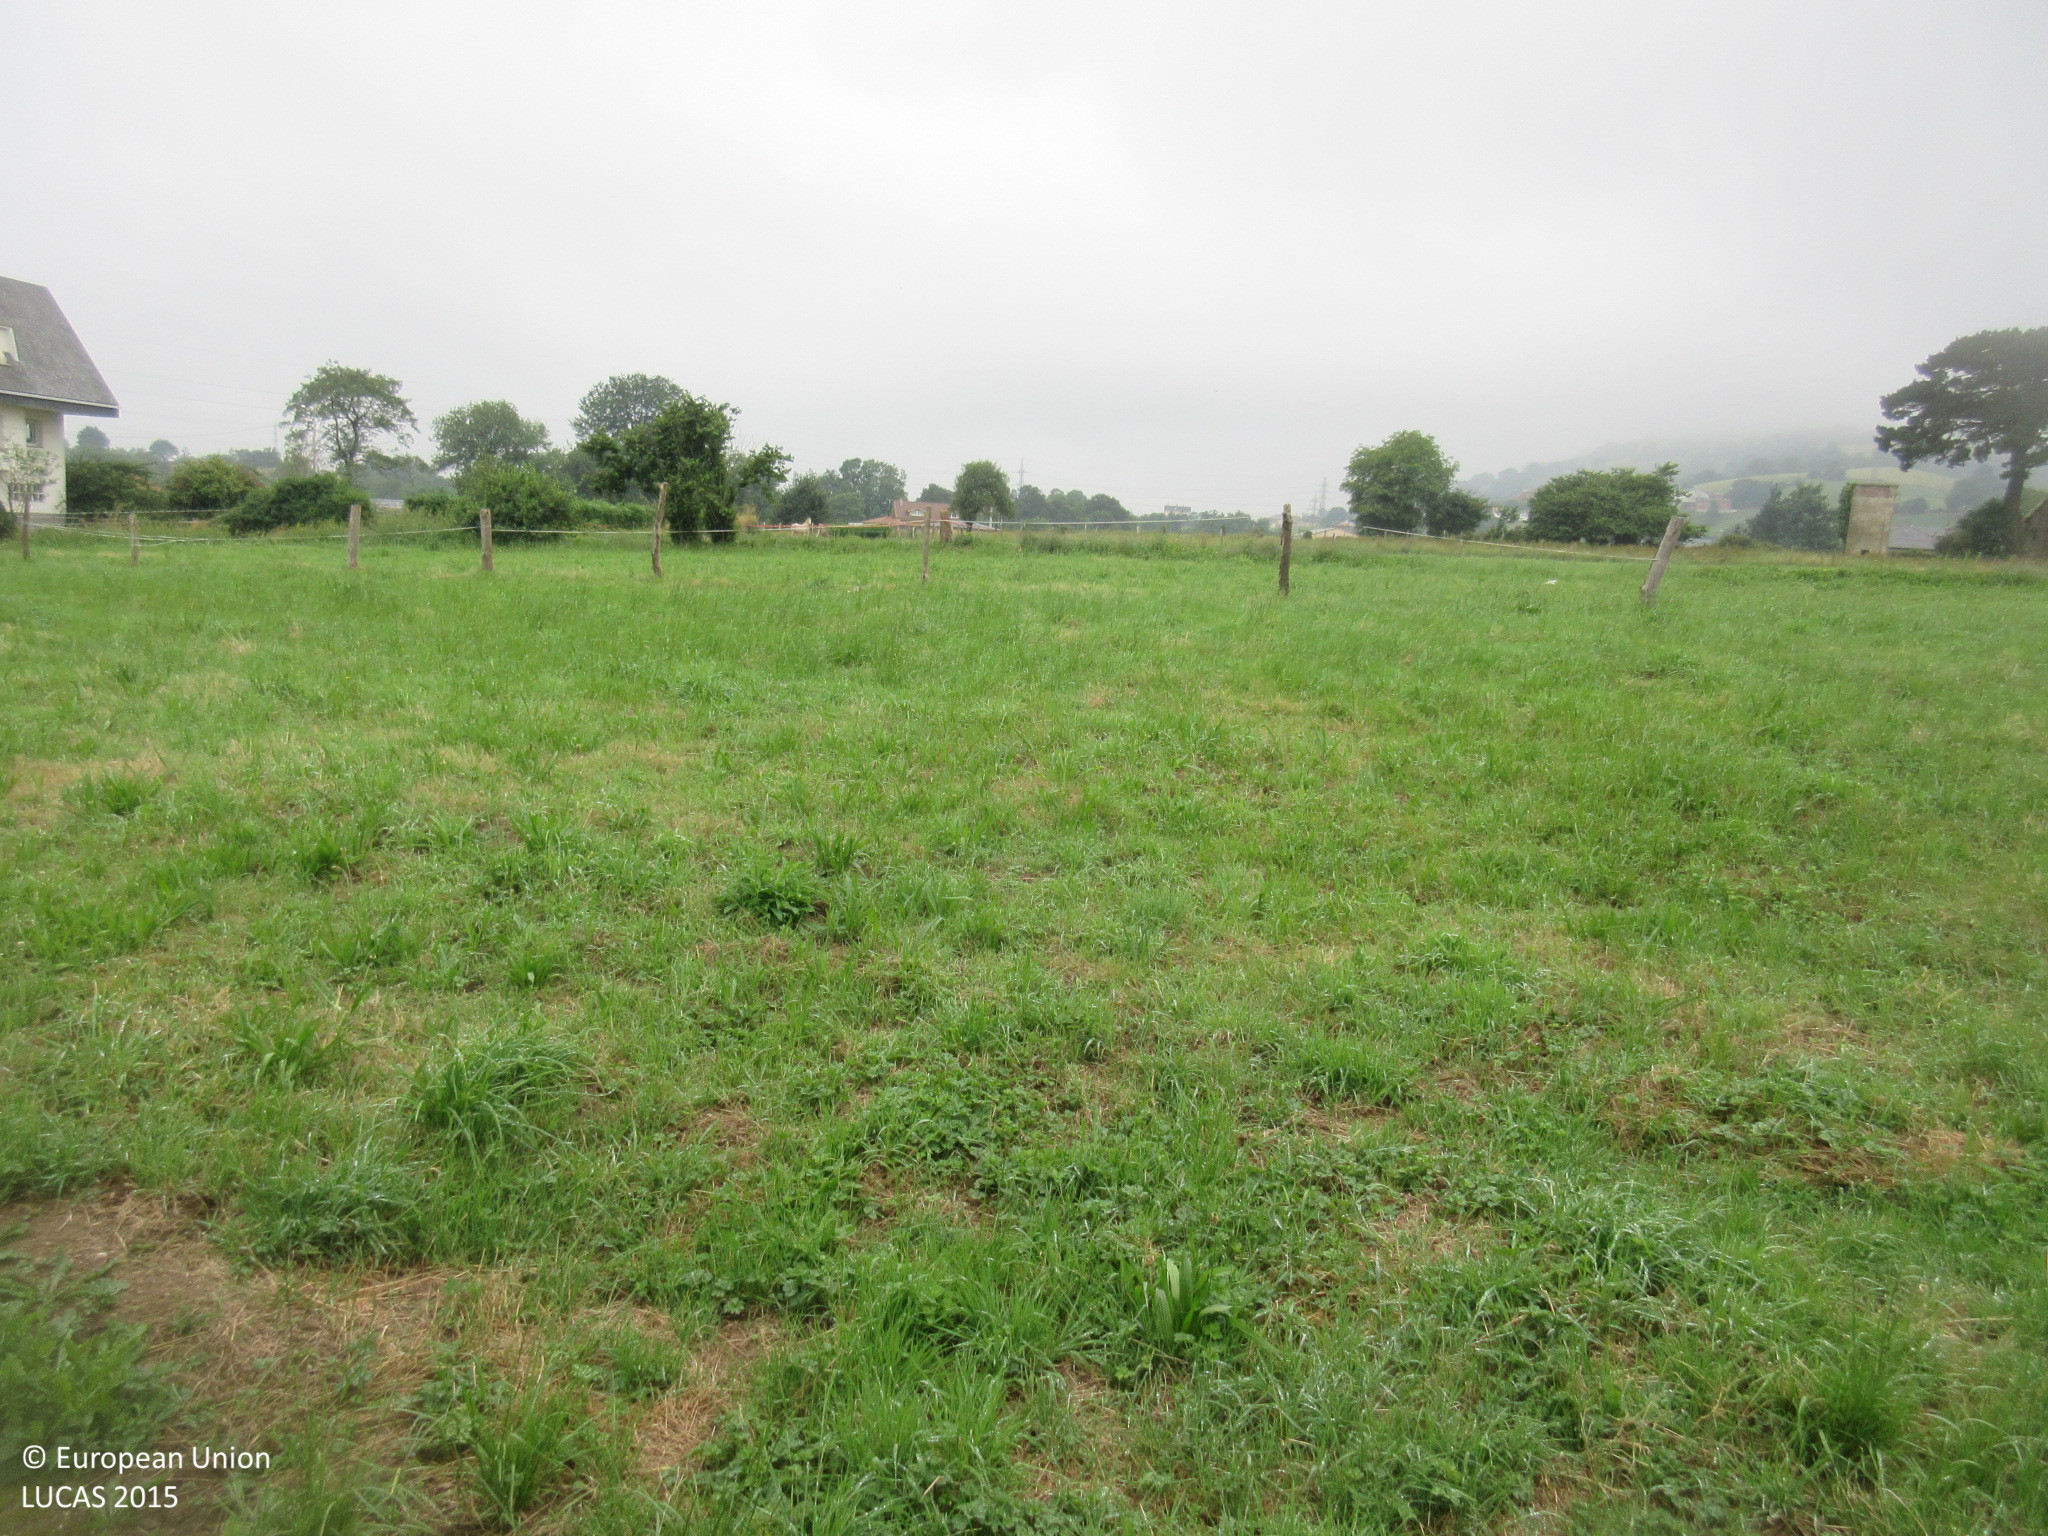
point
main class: Grassland
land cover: Grassland without tree/shrub cover
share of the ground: > 75 %
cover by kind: herbaceous plants 100 %
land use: Agriculture (excluding fallow land and kitchen gardens)
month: July
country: ES
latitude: 43.3948
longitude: -6.3344
